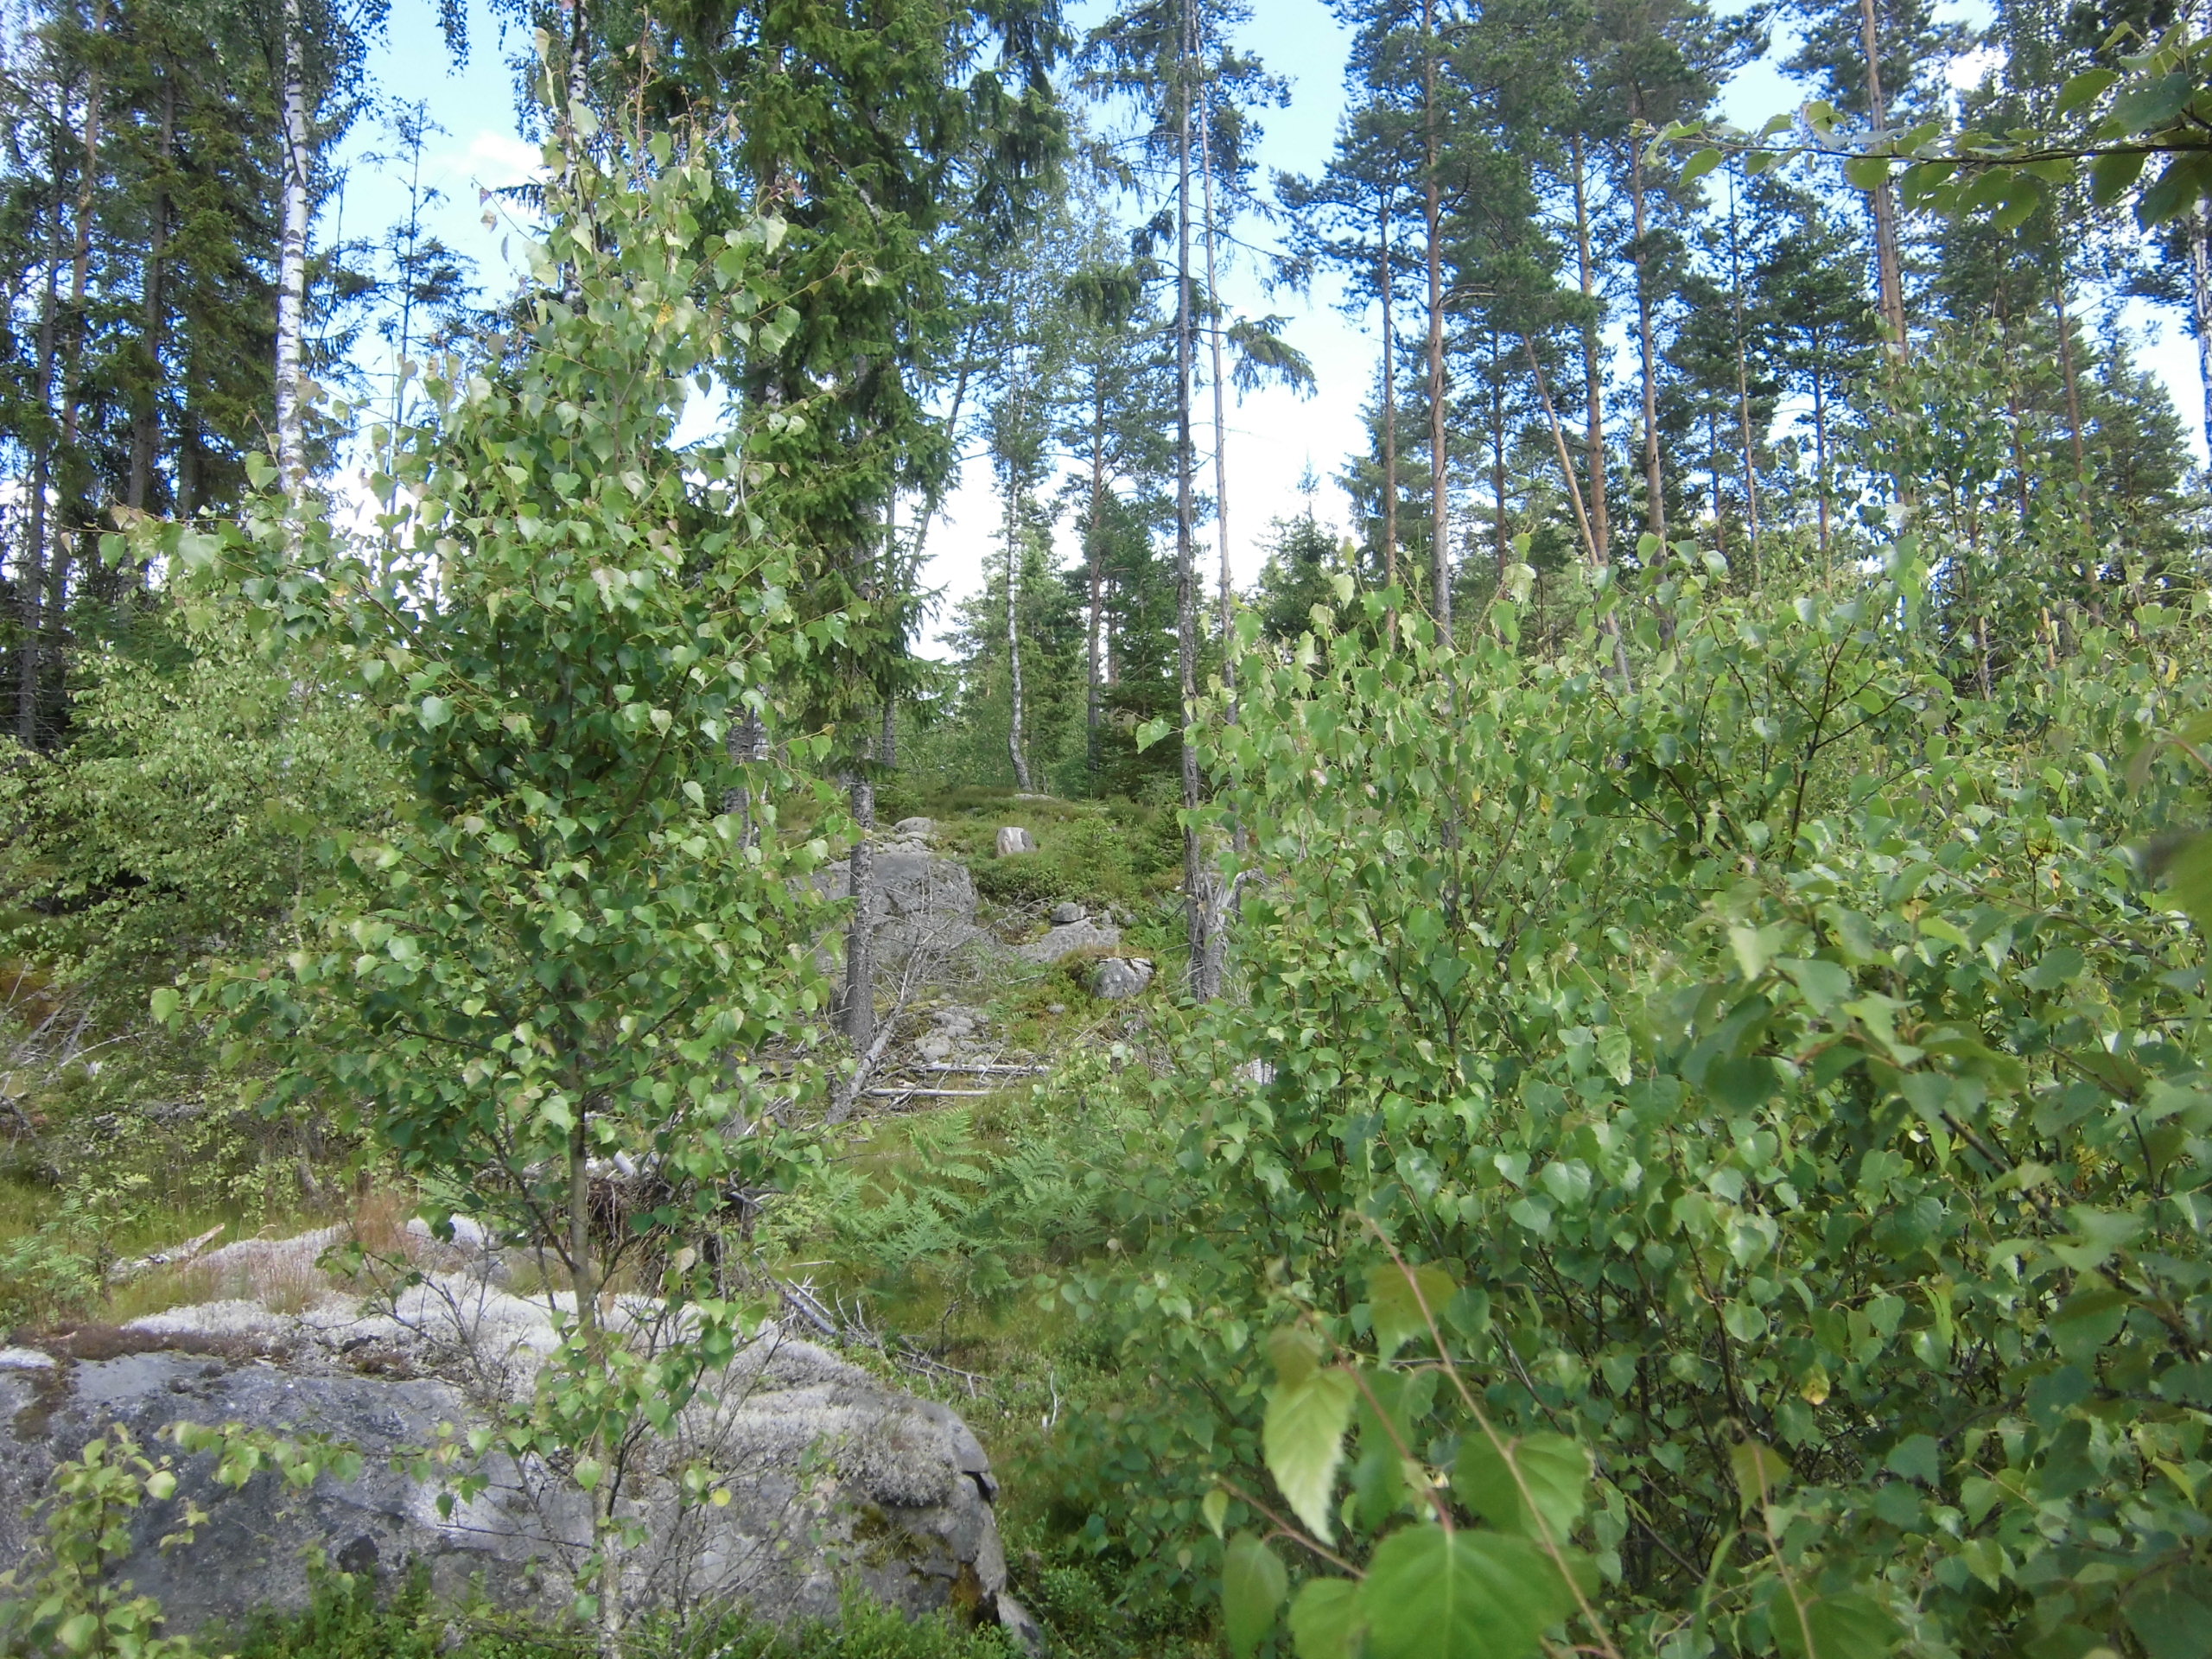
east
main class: Woodland
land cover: Broadleaved woodland
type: boreal forest
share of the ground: 50 - 75 %
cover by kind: broadleaved forest trees 55 %, herbaceous plants 20 %, shrubs 10 %, lichens and mosses 10 %, coniferous forest trees 5 %
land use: Forestry
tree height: > 5 m
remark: Clear cut
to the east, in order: Broadleaved woodland; Pine dominated mixed woodland; Tracks; Pine dominated coniferous woodland; Spruce dominated coniferous woodland; Tracks; Spruce dominated coniferous woodland
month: July
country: SE
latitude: 57.2092
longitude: 15.4110
